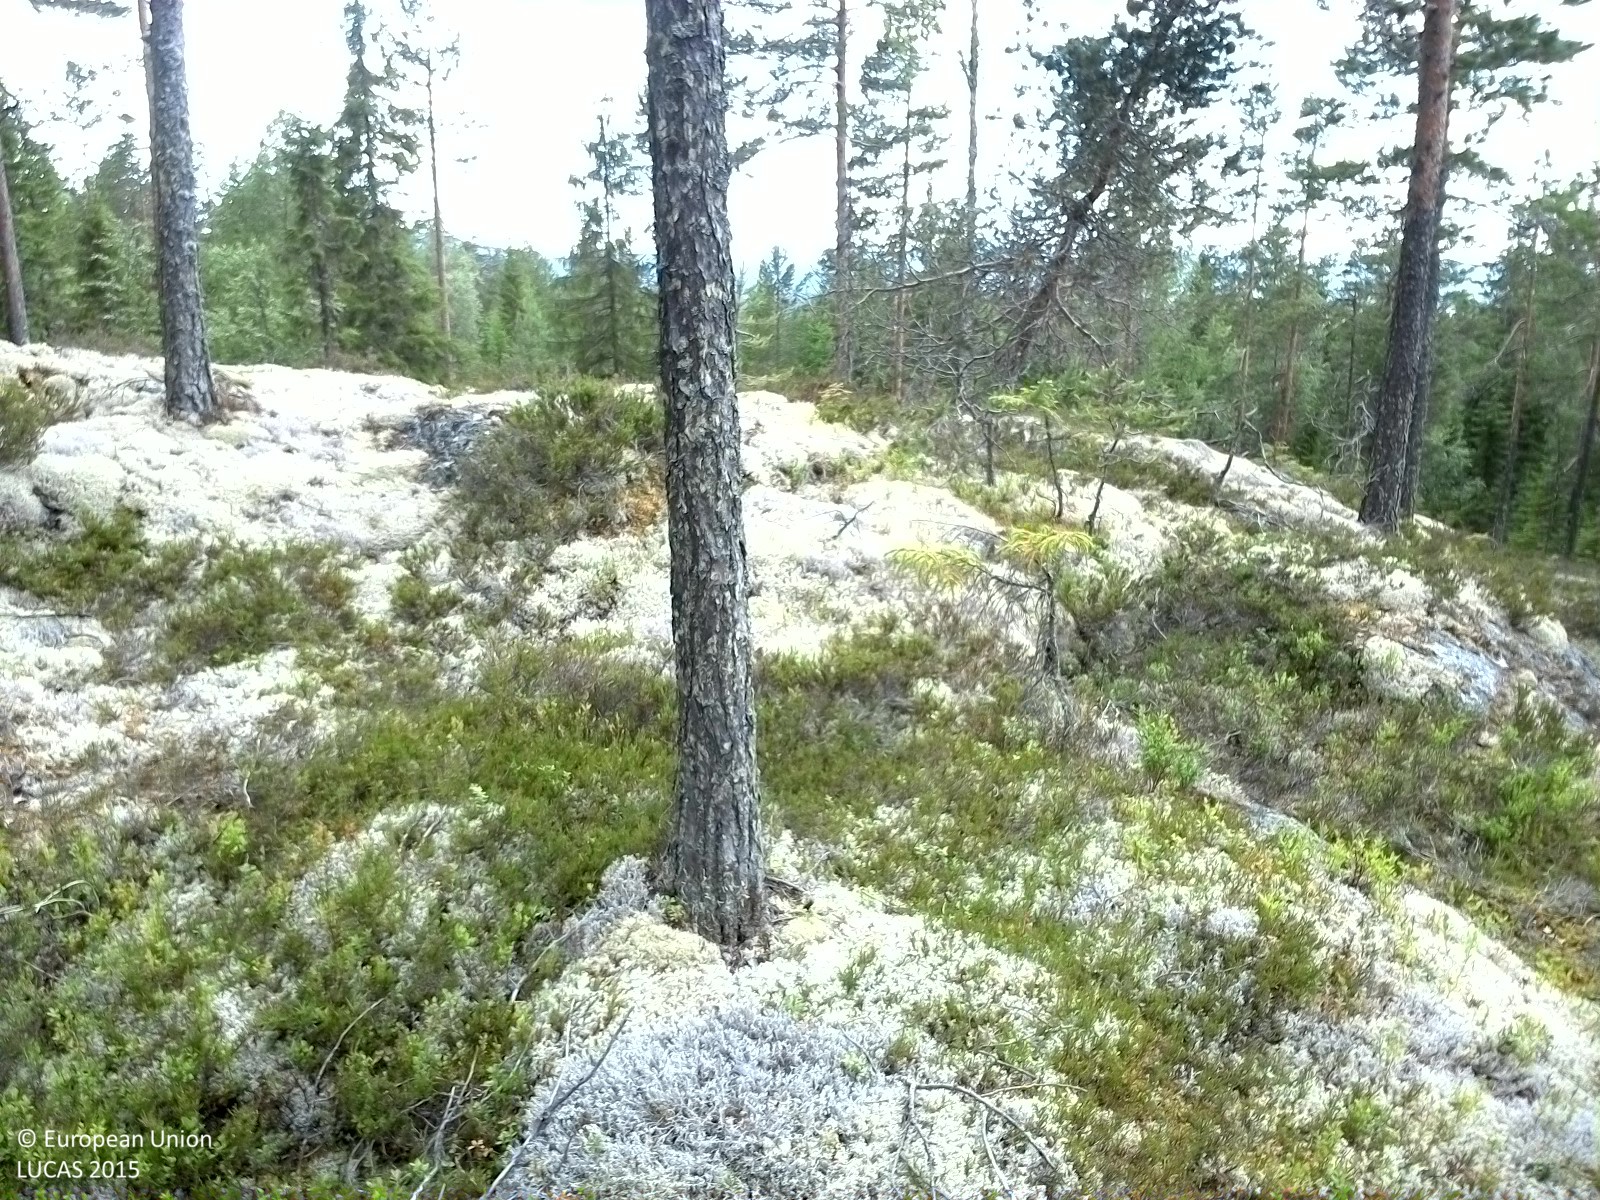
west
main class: Woodland
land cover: Pine dominated coniferous woodland
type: boreal forest
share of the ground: 10 - 25 %
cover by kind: shrubs 35 %, lichens and mosses 30 %, unconsolidated bare surface 20 %, coniferous forest trees 15 %
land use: Forestry
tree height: > 5 m
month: July
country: SE
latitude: 62.6368
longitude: 17.2532
